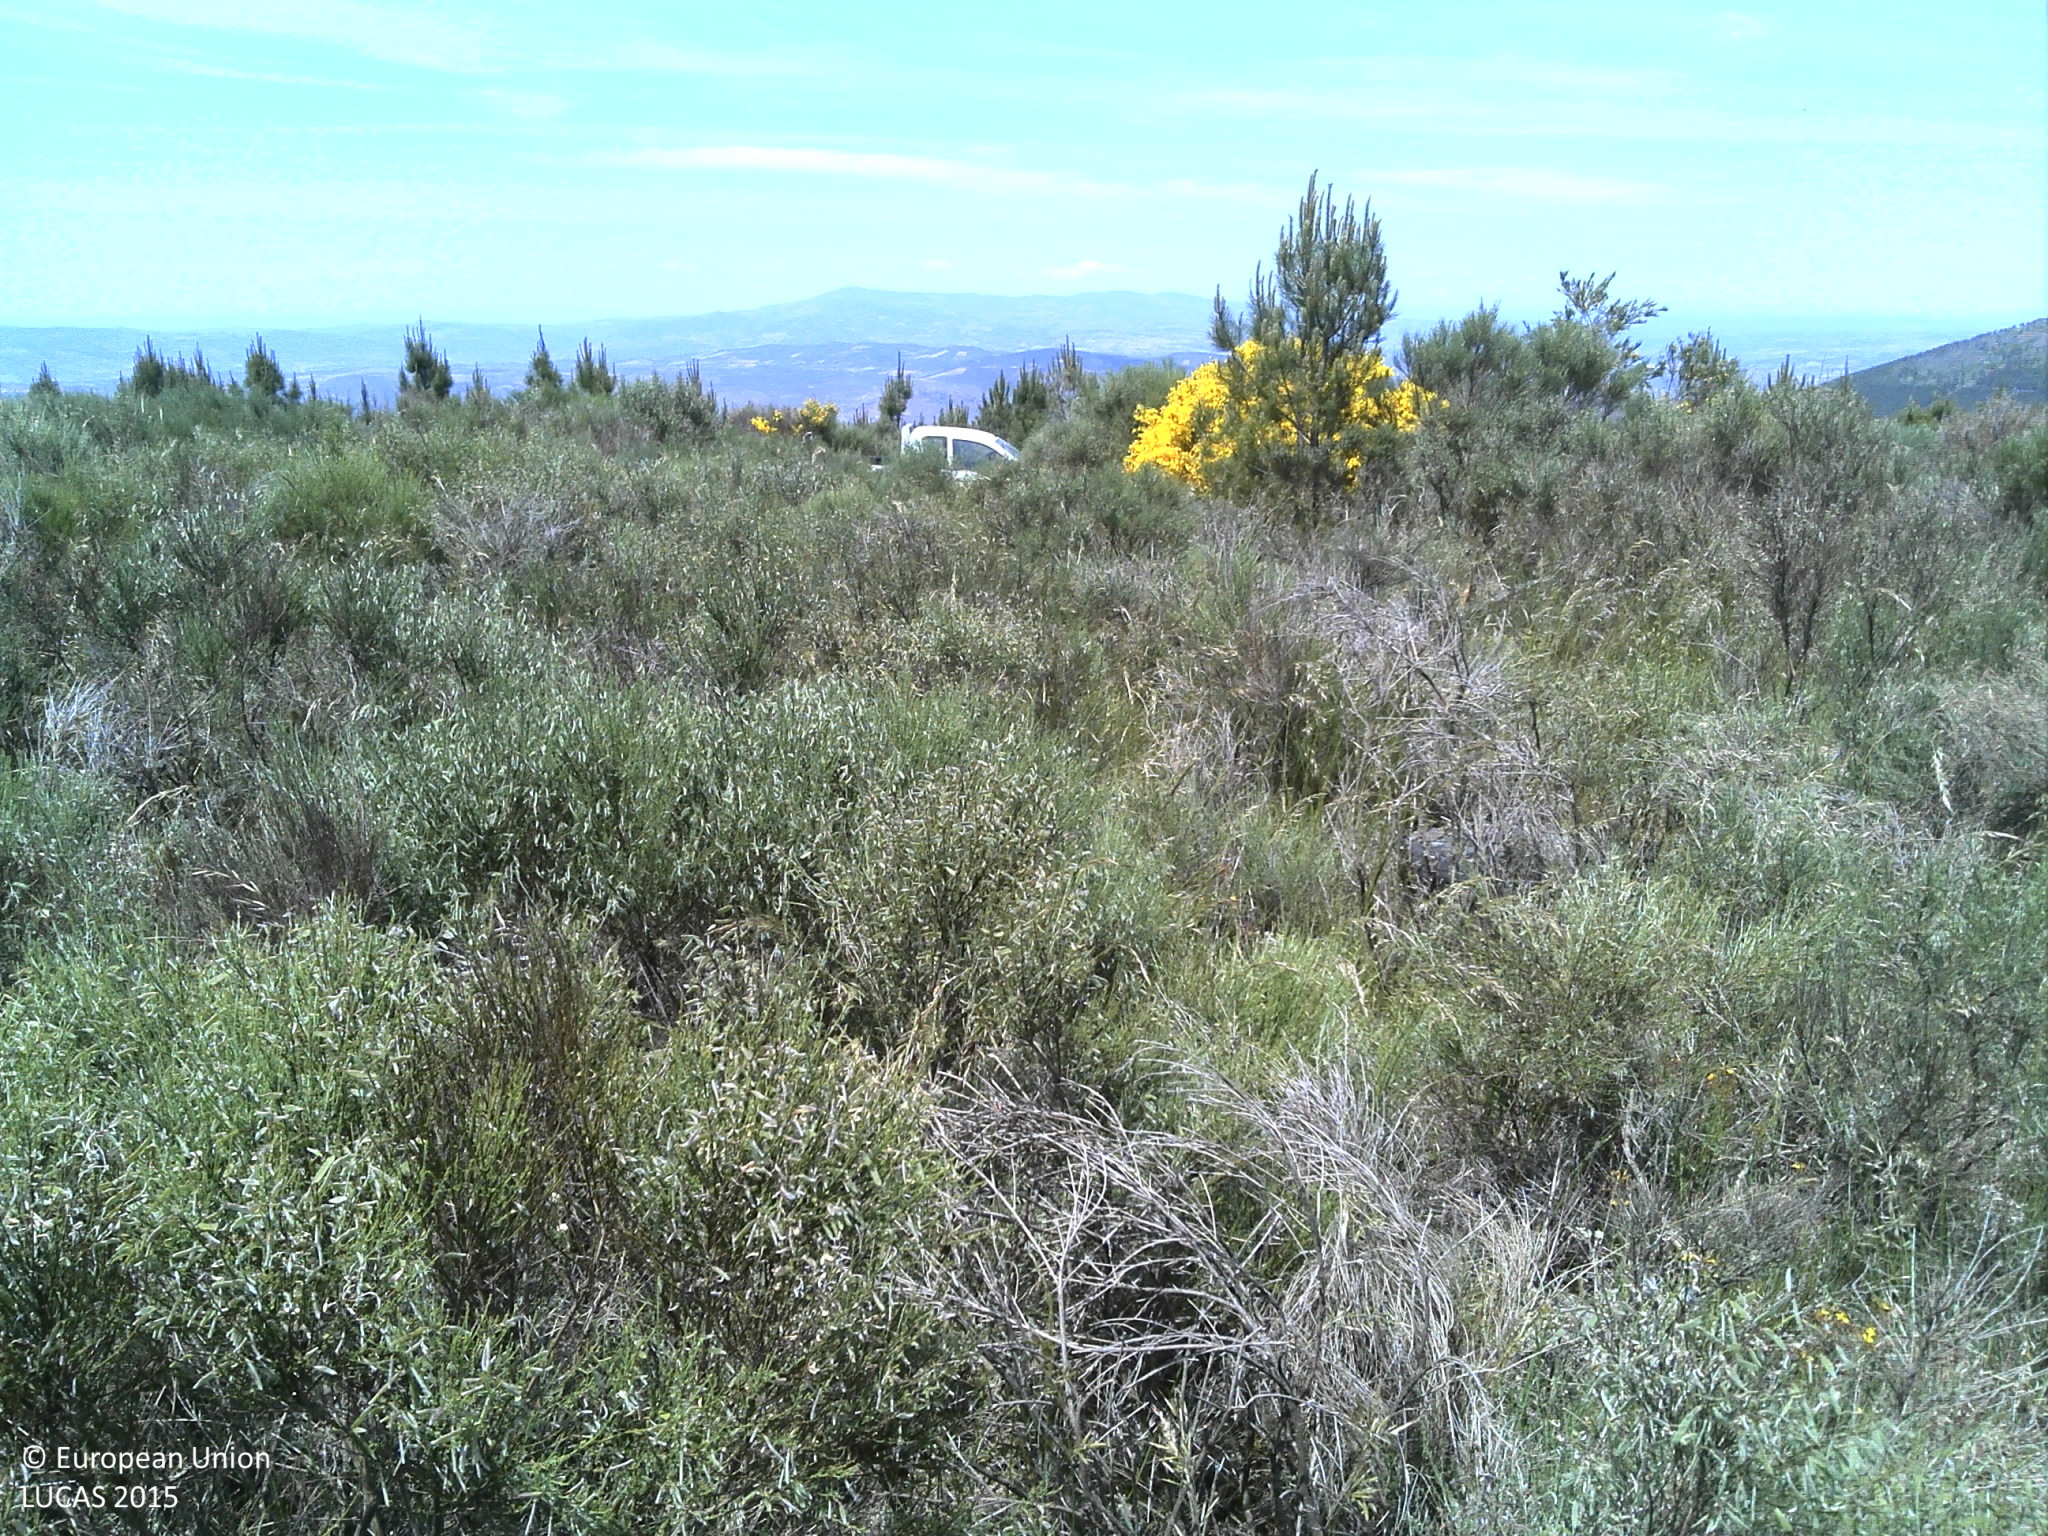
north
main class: Shrubland
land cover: Shrubland with sparse tree cover
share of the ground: > 75 %
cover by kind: shrubs 90 %, coniferous forest trees 5 %, consolidated bare surface 5 %
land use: Forestry
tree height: < 5 m
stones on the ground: < 10 %
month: May
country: PT
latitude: 41.1720
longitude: -6.9751
